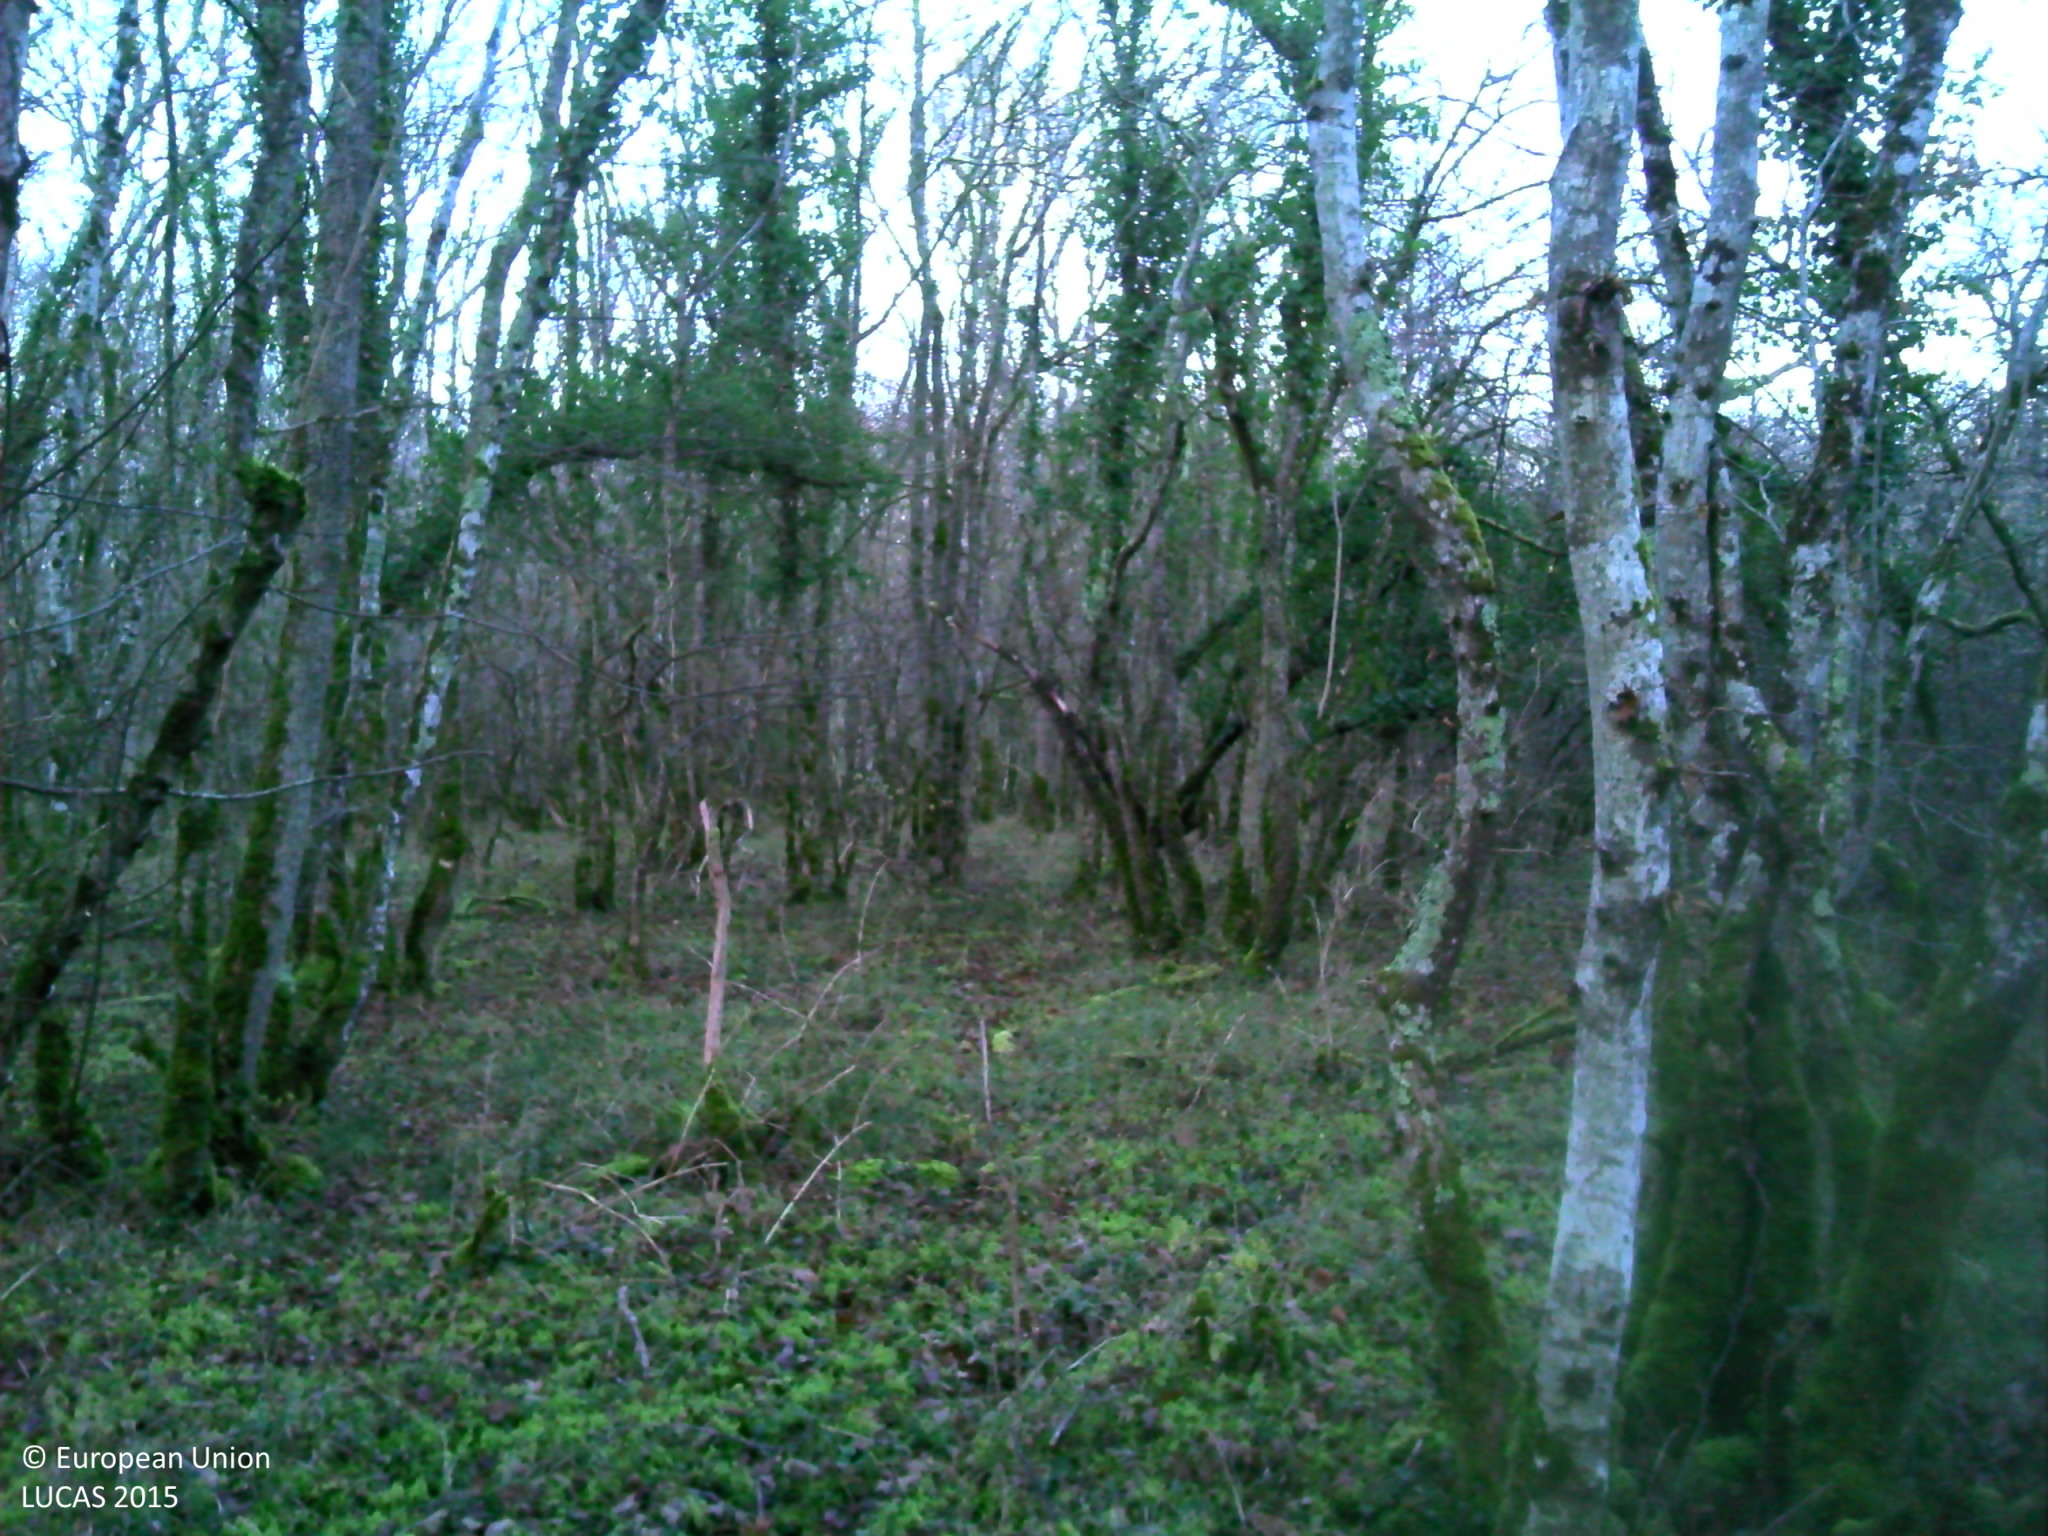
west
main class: Woodland
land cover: Broadleaved woodland
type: mesophytic deciduous forest
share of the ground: > 75 %
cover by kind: broadleaved forest trees 100 %
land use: Forestry
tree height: > 5 m
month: December
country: FR
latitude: 47.3829
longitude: 3.5193
